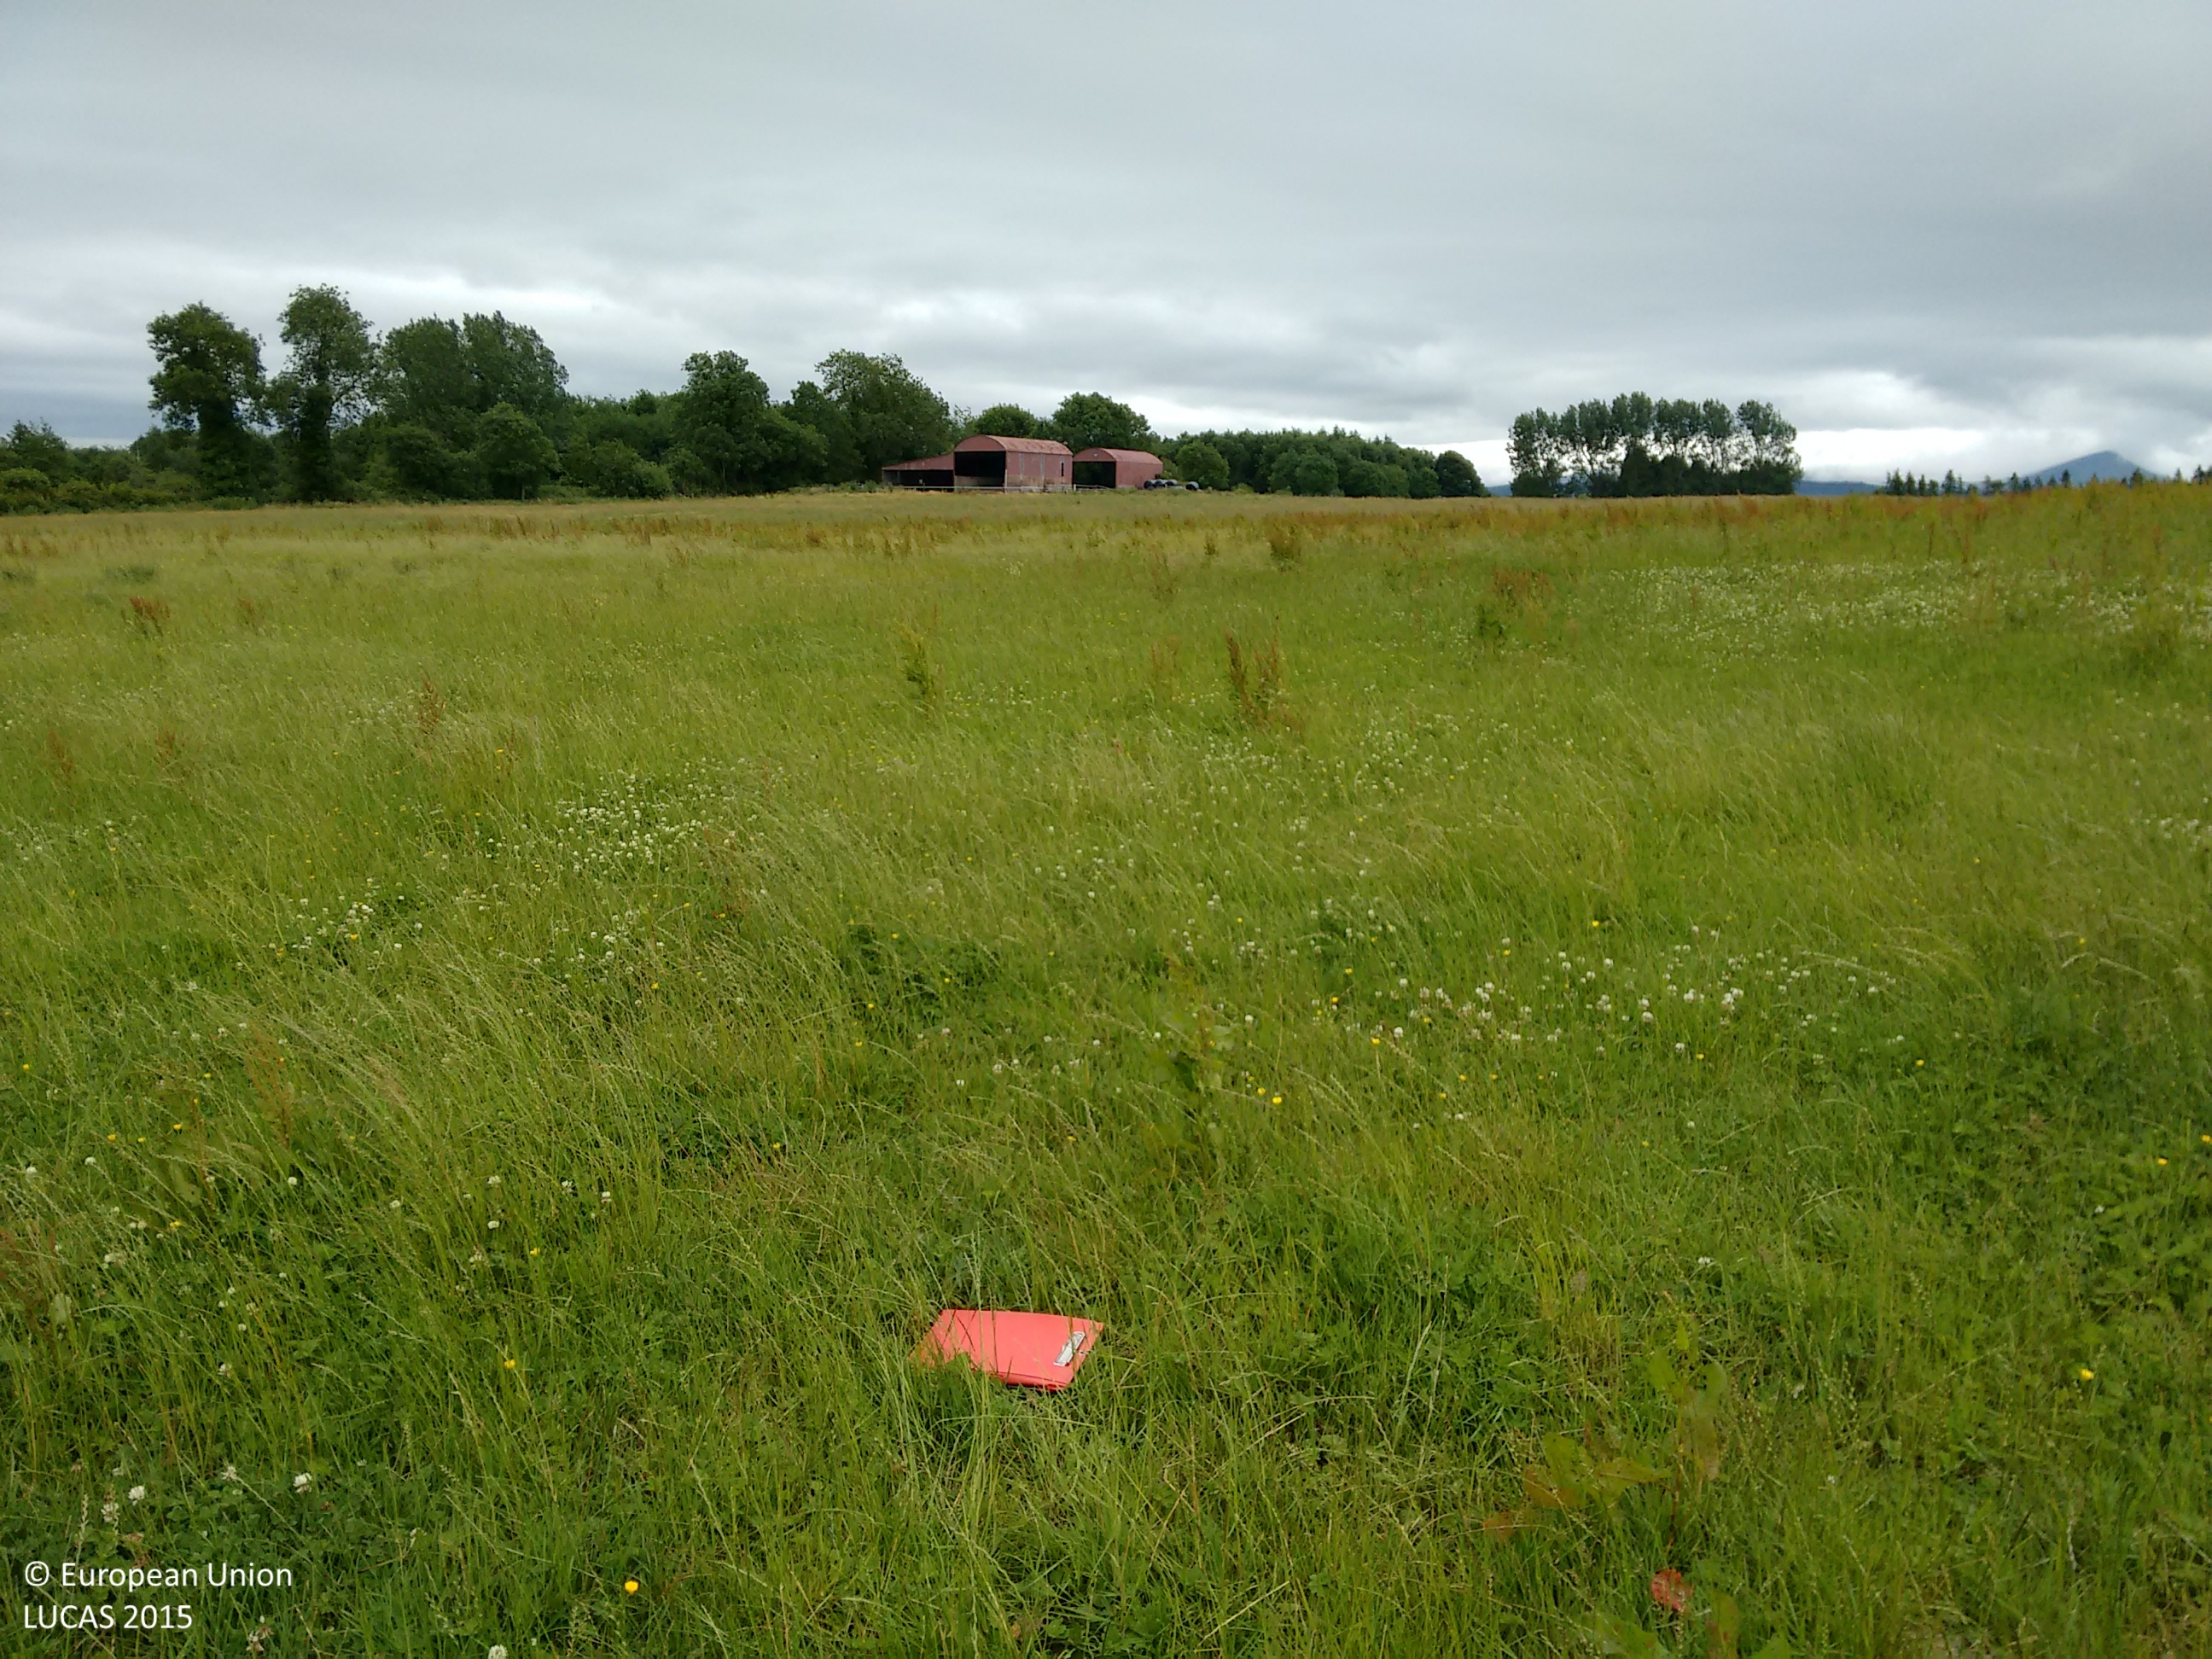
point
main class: Grassland
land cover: Grassland without tree/shrub cover
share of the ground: > 75 %
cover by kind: herbaceous plants 100 %
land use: Agriculture (excluding fallow land and kitchen gardens)
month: July
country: IE
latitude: 52.4989
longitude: -8.2289
